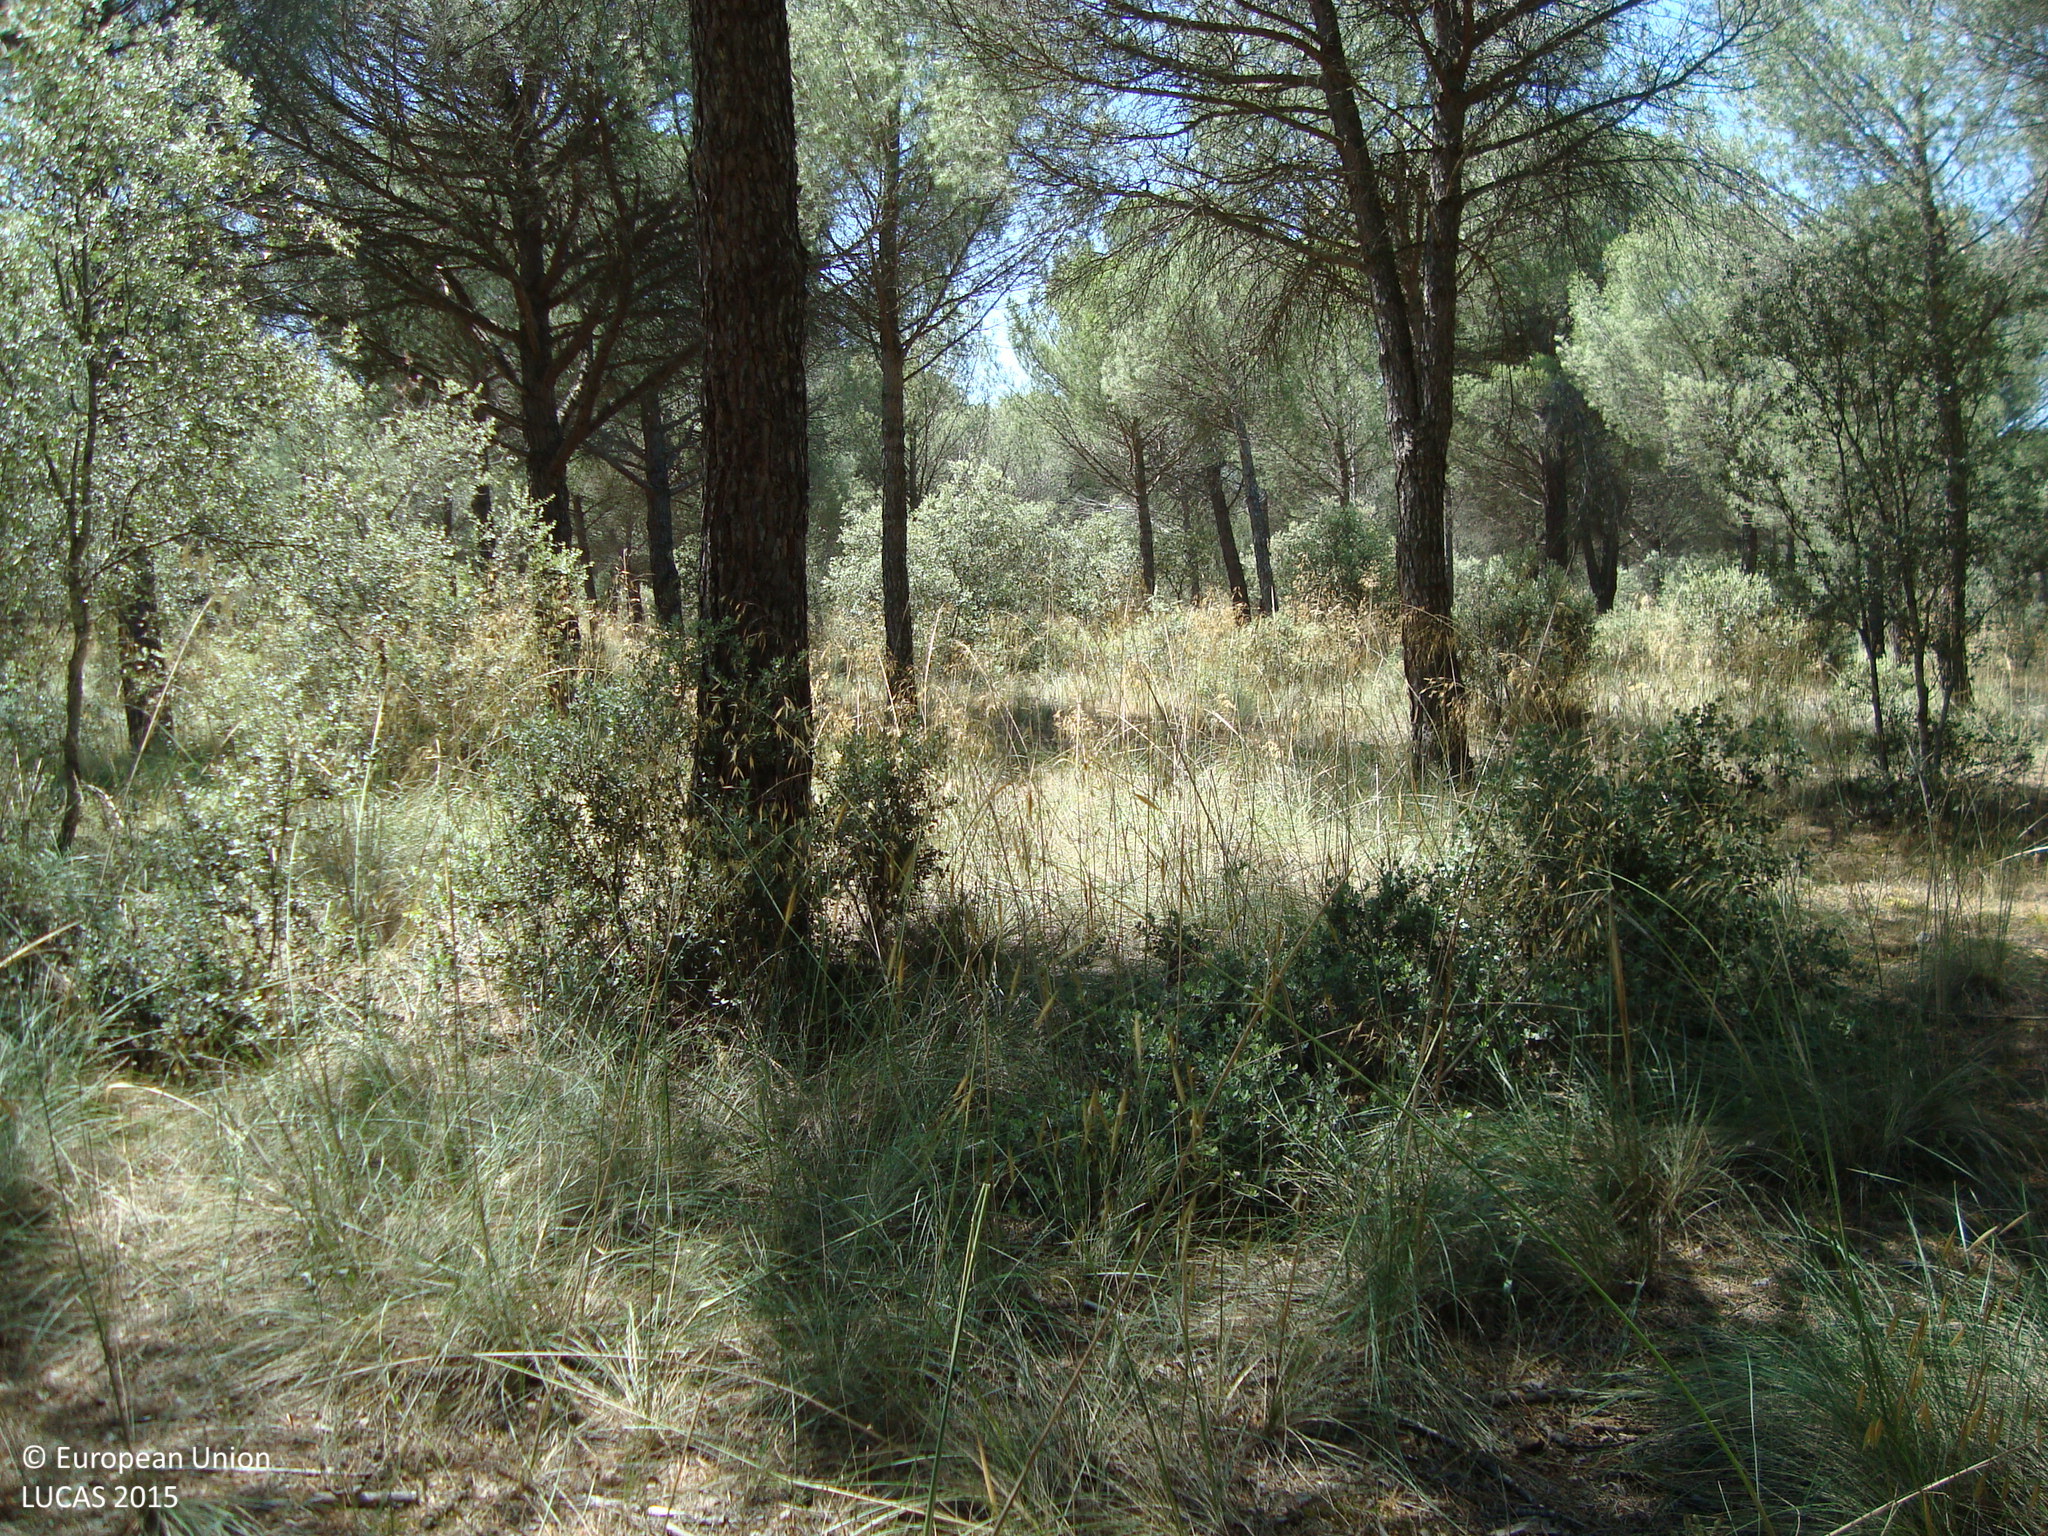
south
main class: Woodland
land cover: Pine dominated mixed woodland
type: coniferous forest of the mediterranean region
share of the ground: 50 - 75 %
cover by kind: coniferous forest trees 60 %, broadleaved forest trees 20 %, shrubs 10 %, herbaceous plants 10 %
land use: Forestry
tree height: > 5 m
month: June
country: ES
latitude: 41.6278
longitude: -4.2119
